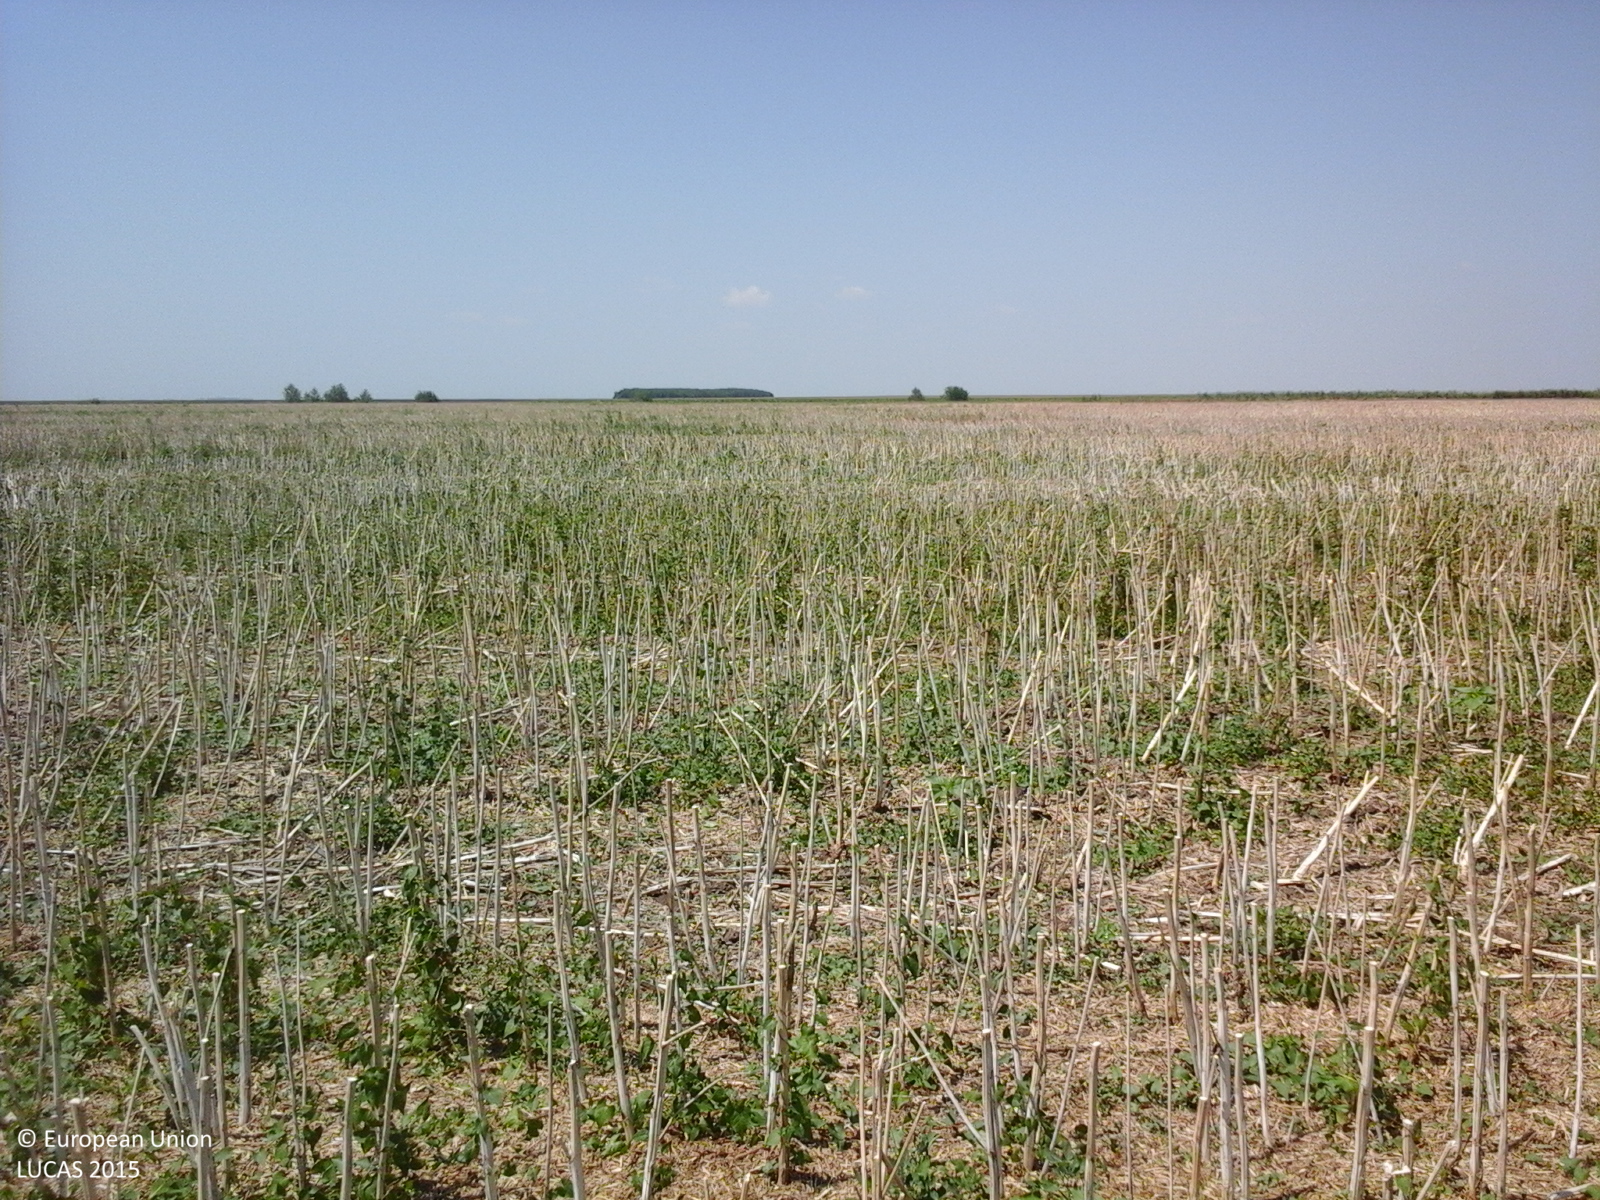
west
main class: Cropland
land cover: Rape and turnip rape
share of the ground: < 10 %
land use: Agriculture (excluding fallow land and kitchen gardens)
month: July
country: RO
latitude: 44.4838
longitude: 27.0929
